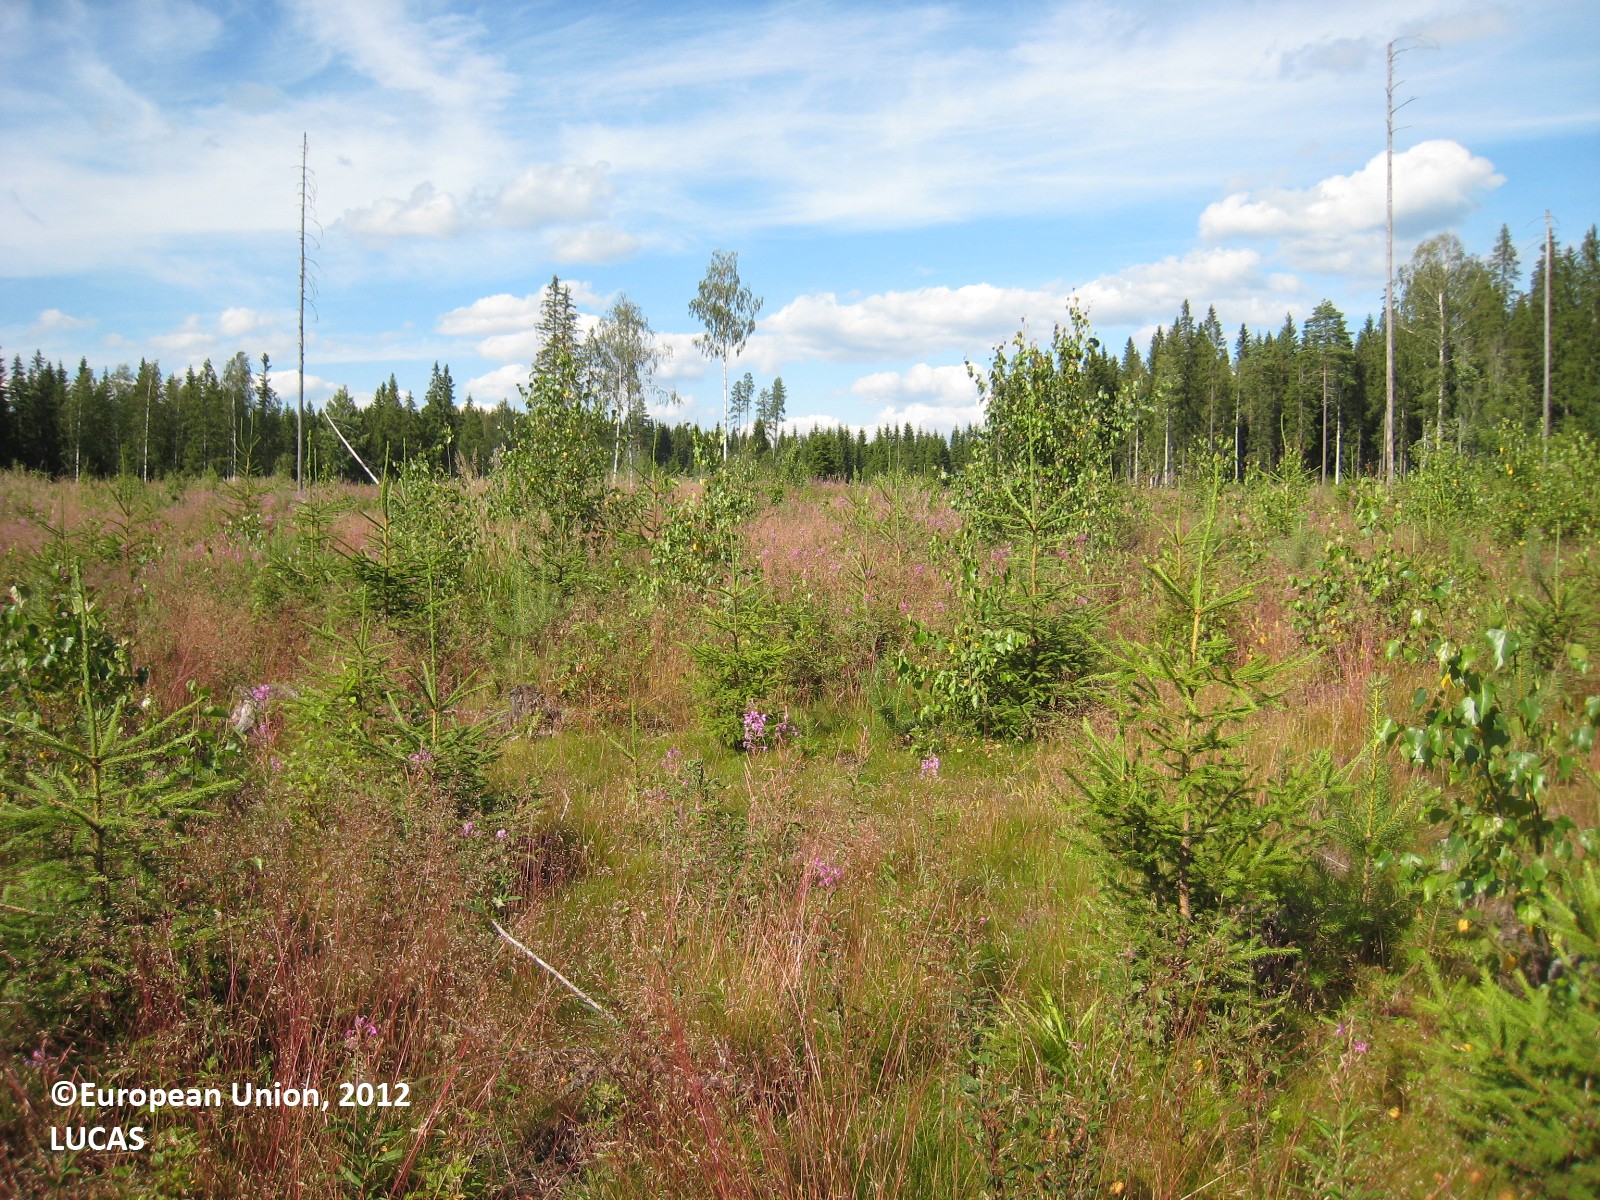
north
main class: Woodland
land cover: Other mixed woodland
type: boreal forest
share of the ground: 25 - 50 %
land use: Forestry
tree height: < 5 m
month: July
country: FI
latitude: 62.6937
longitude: 27.2947
